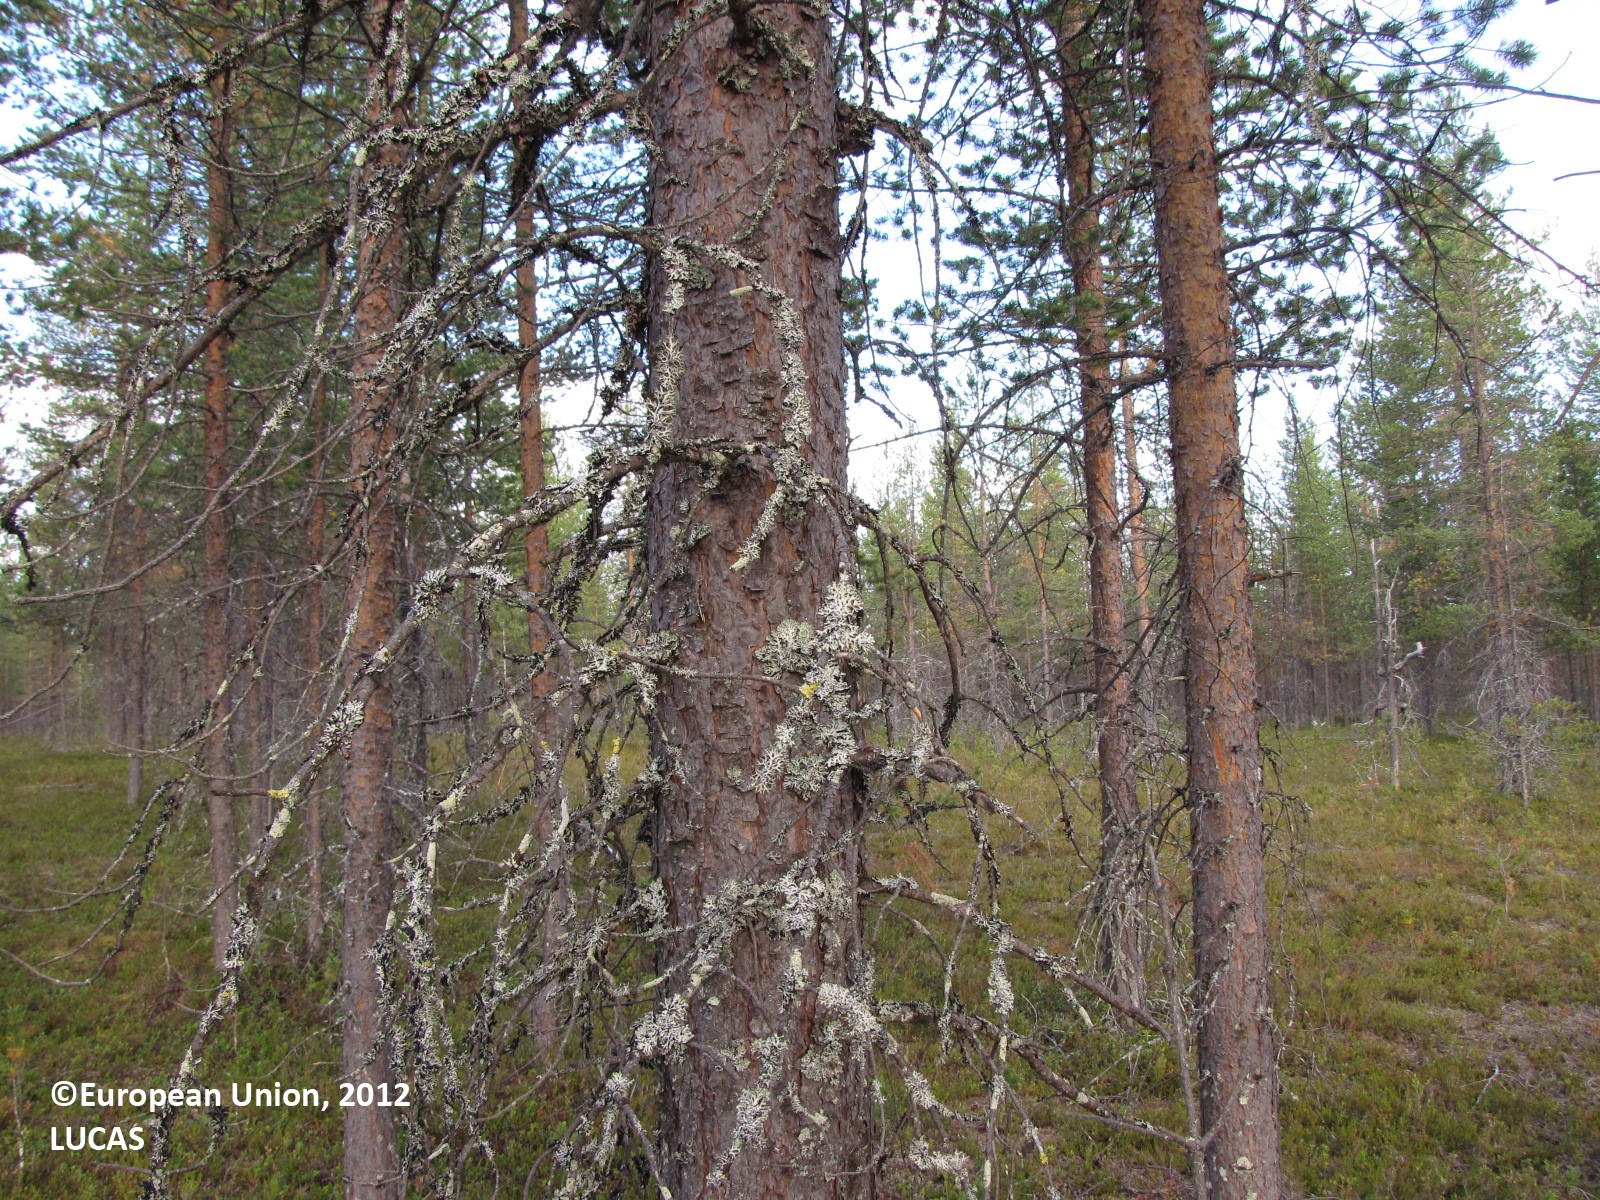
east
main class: Woodland
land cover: Pine dominated coniferous woodland
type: boreal forest
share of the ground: 25 - 50 %
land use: Forestry
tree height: > 5 m
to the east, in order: Pine dominated coniferous woodland
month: August
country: FI
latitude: 67.0228
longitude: 25.0375
